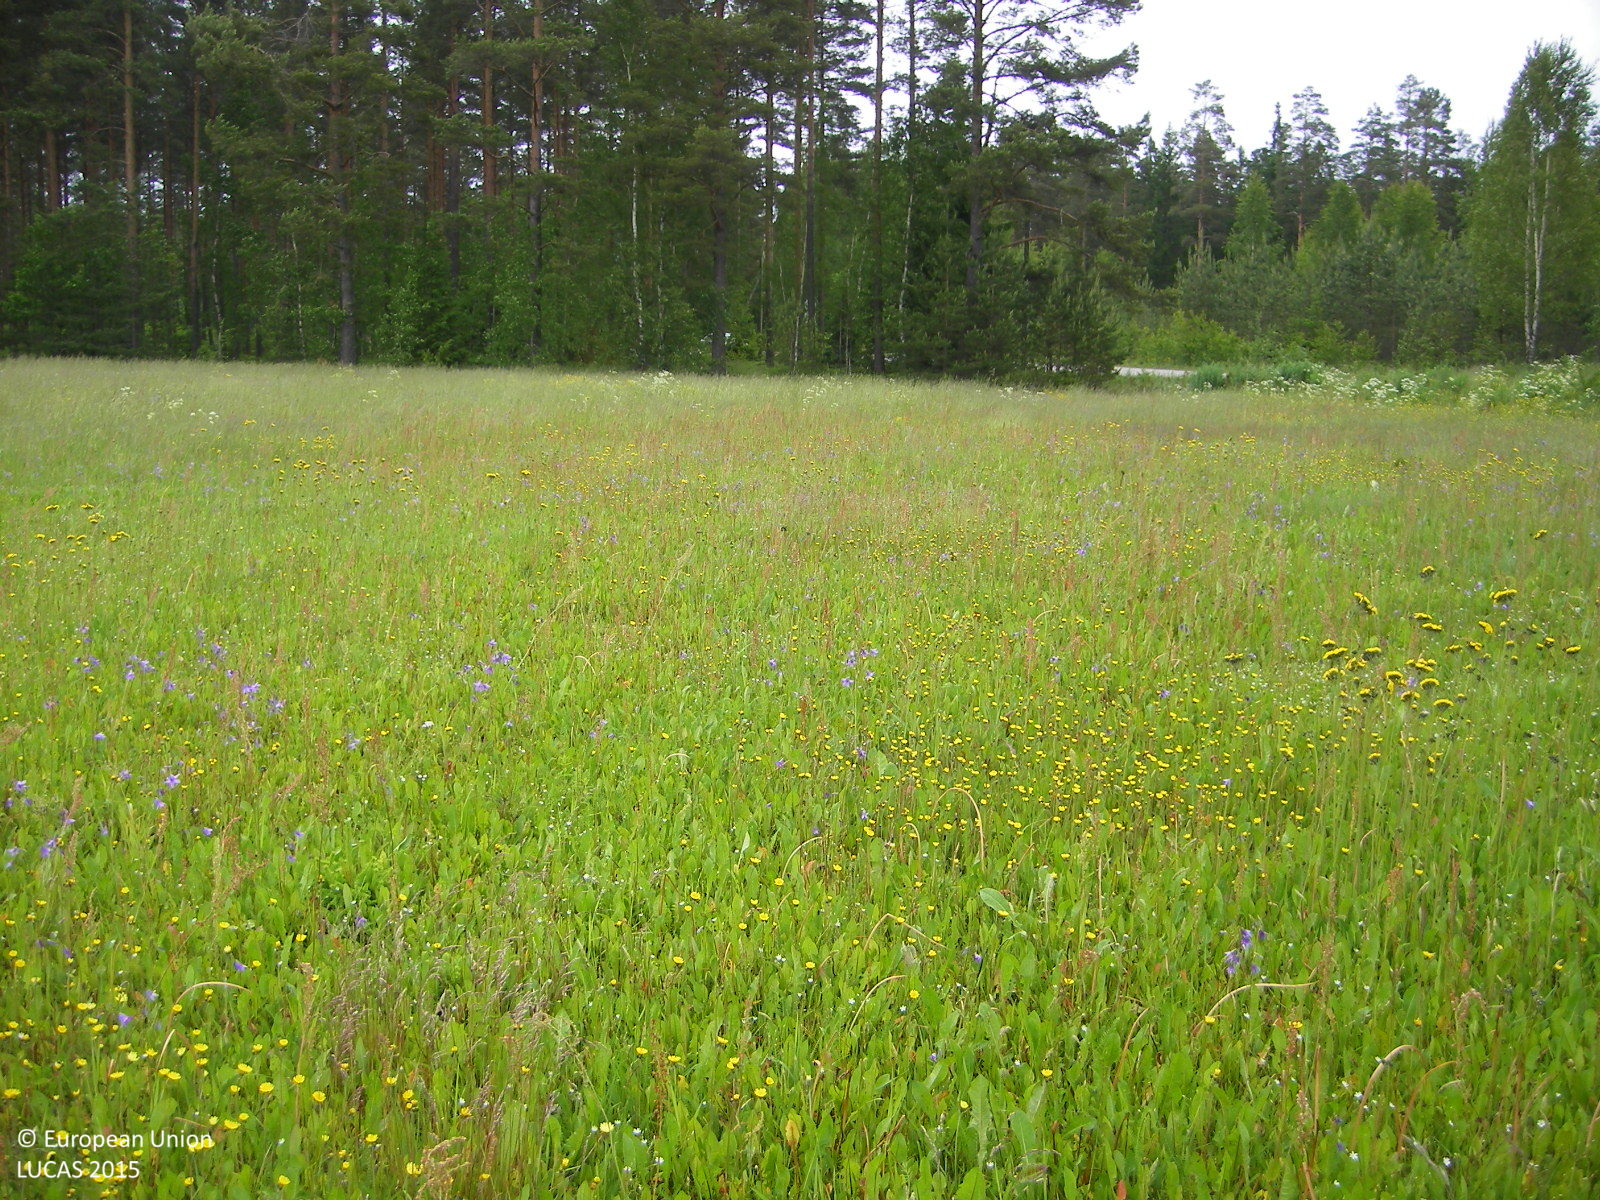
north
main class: Grassland
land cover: Spontaneously vegetated surfaces
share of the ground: > 75 %
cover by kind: herbaceous plants 100 %
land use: Fallow land
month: June
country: FI
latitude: 60.2854
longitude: 23.2320
